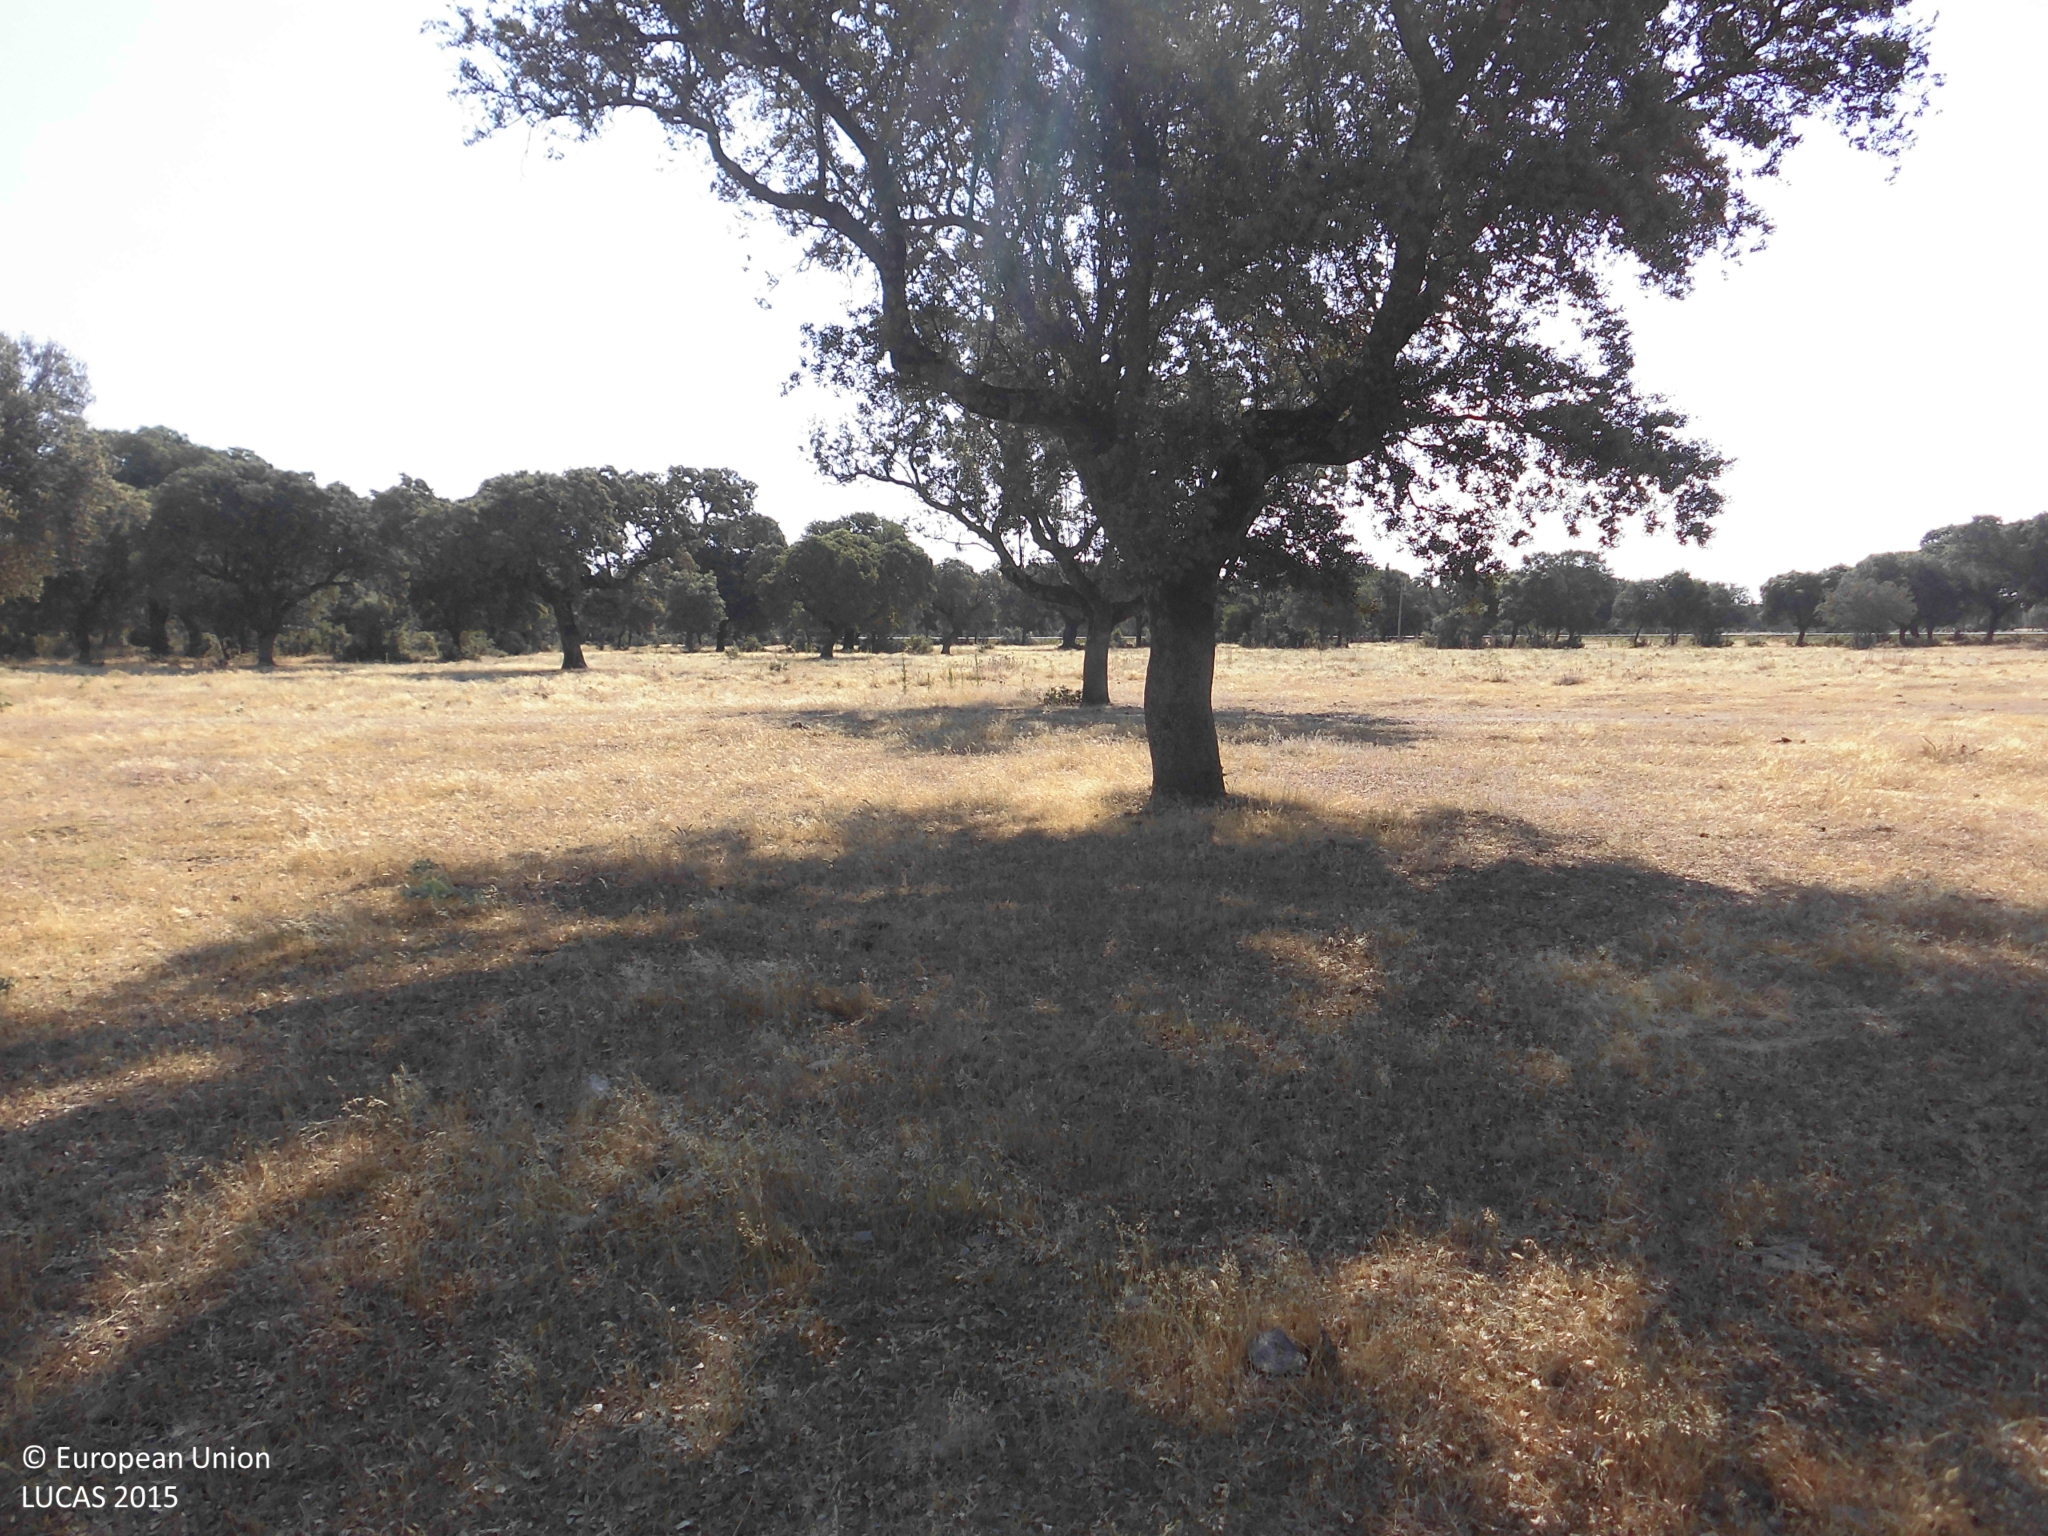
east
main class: Woodland
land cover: Broadleaved woodland
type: broadleaved evergreen forest
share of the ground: 10 - 25 %
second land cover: Grassland without tree/shrub cover
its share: > 75 %
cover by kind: herbaceous plants 85 %, broadleaved forest trees 15 %
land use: Forestry
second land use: Agriculture (excluding fallow land and kitchen gardens)
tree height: > 5 m
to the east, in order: Broadleaved woodland; Grassland without tree/shrub cover; Other structural elements; Fences; Grass margins; Paved roads, cycling and walking lanes; Grass margins; Electric lines; Fences; Grass margins; Broadleaved woodland; Other structural elements; Grassland with sparse tree/shrub cover
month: June
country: ES
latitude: 39.9468
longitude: -5.4967
